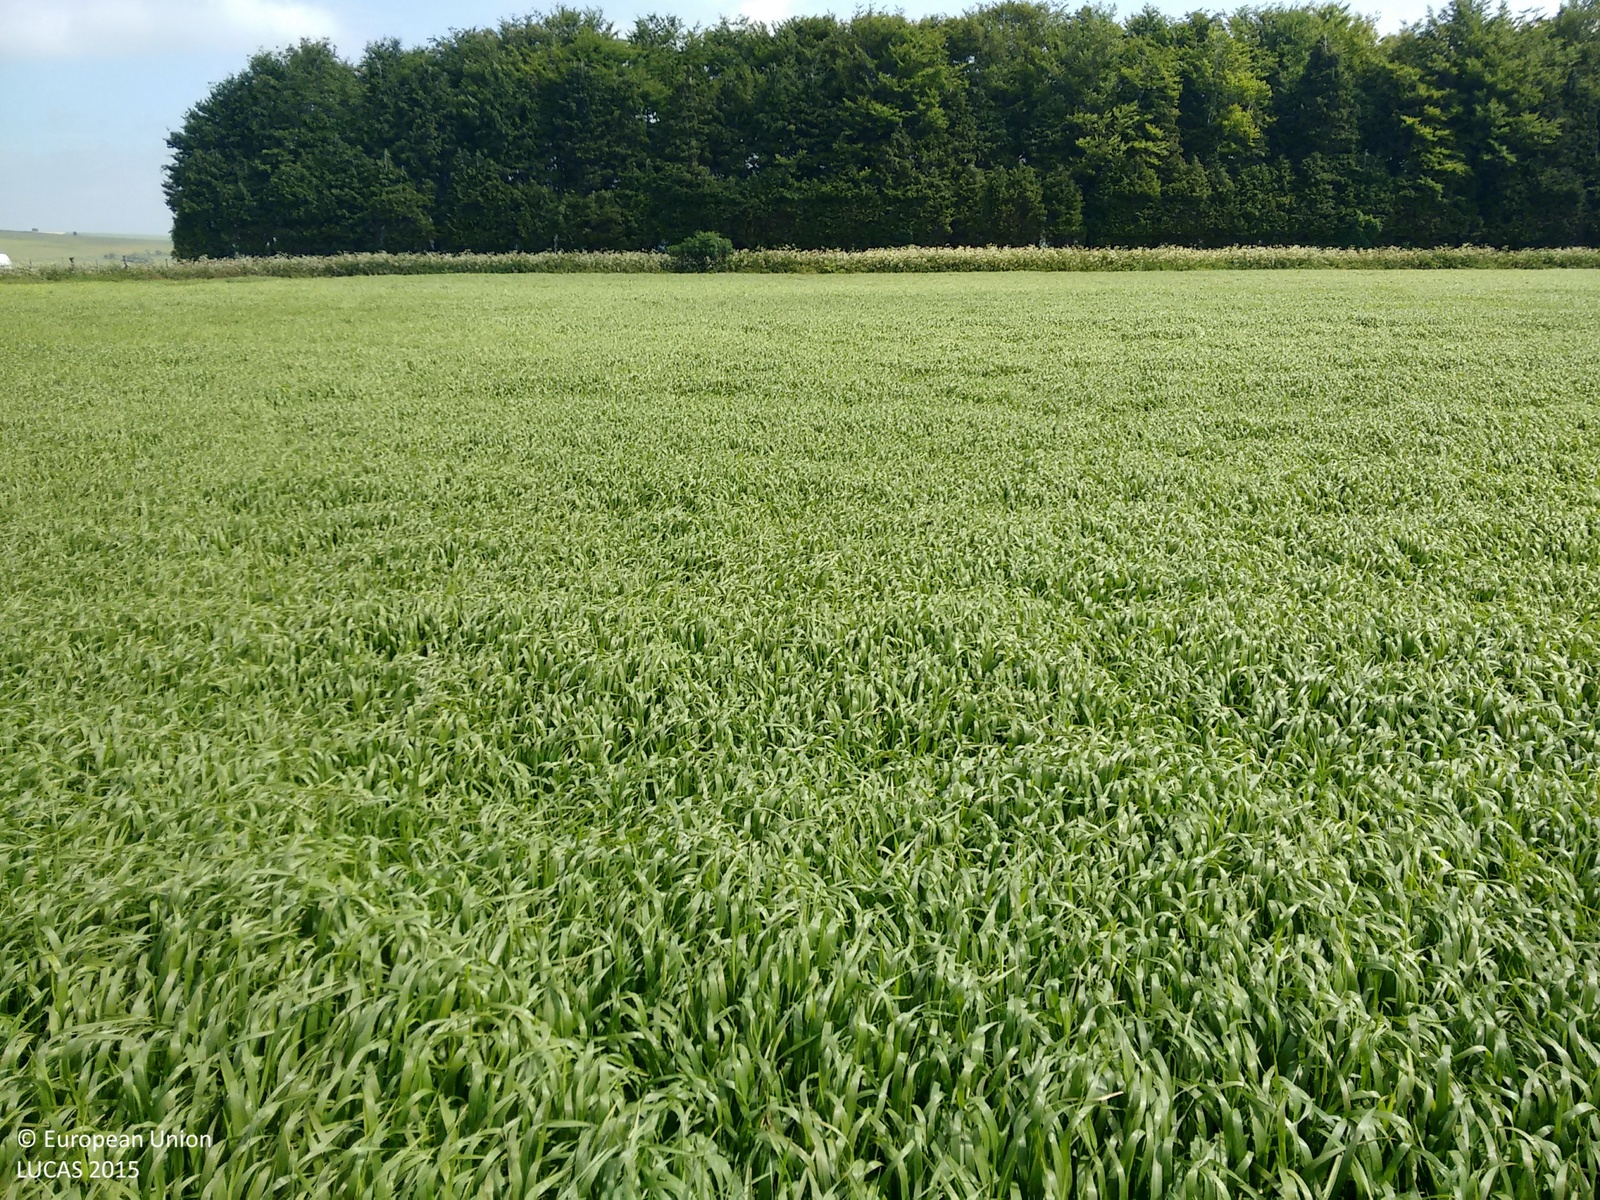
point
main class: Cropland
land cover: Barley
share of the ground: > 75 %
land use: Agriculture (excluding fallow land and kitchen gardens)
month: June
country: GB
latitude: 51.1246
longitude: -2.2210
